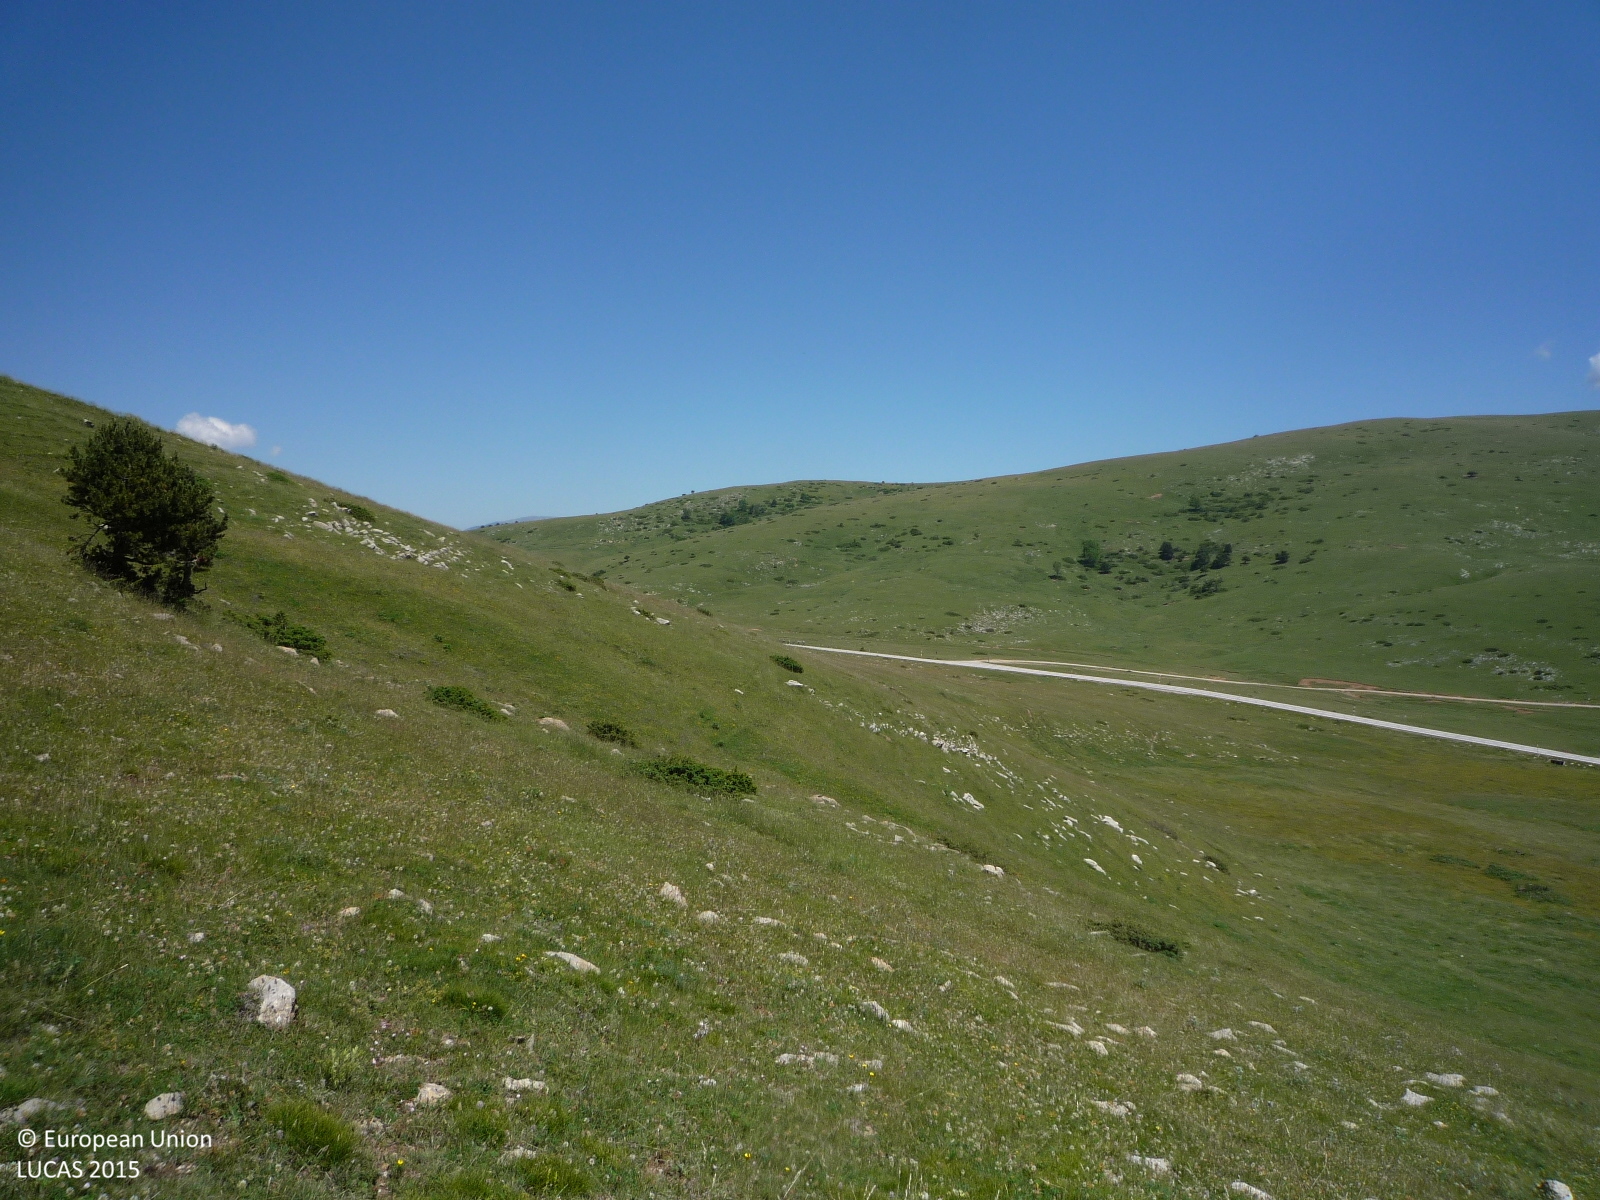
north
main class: Grassland
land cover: Grassland without tree/shrub cover
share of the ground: > 75 %
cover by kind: herbaceous plants 100 %
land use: Sport
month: June
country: ES
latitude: 42.3165
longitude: 1.9677
